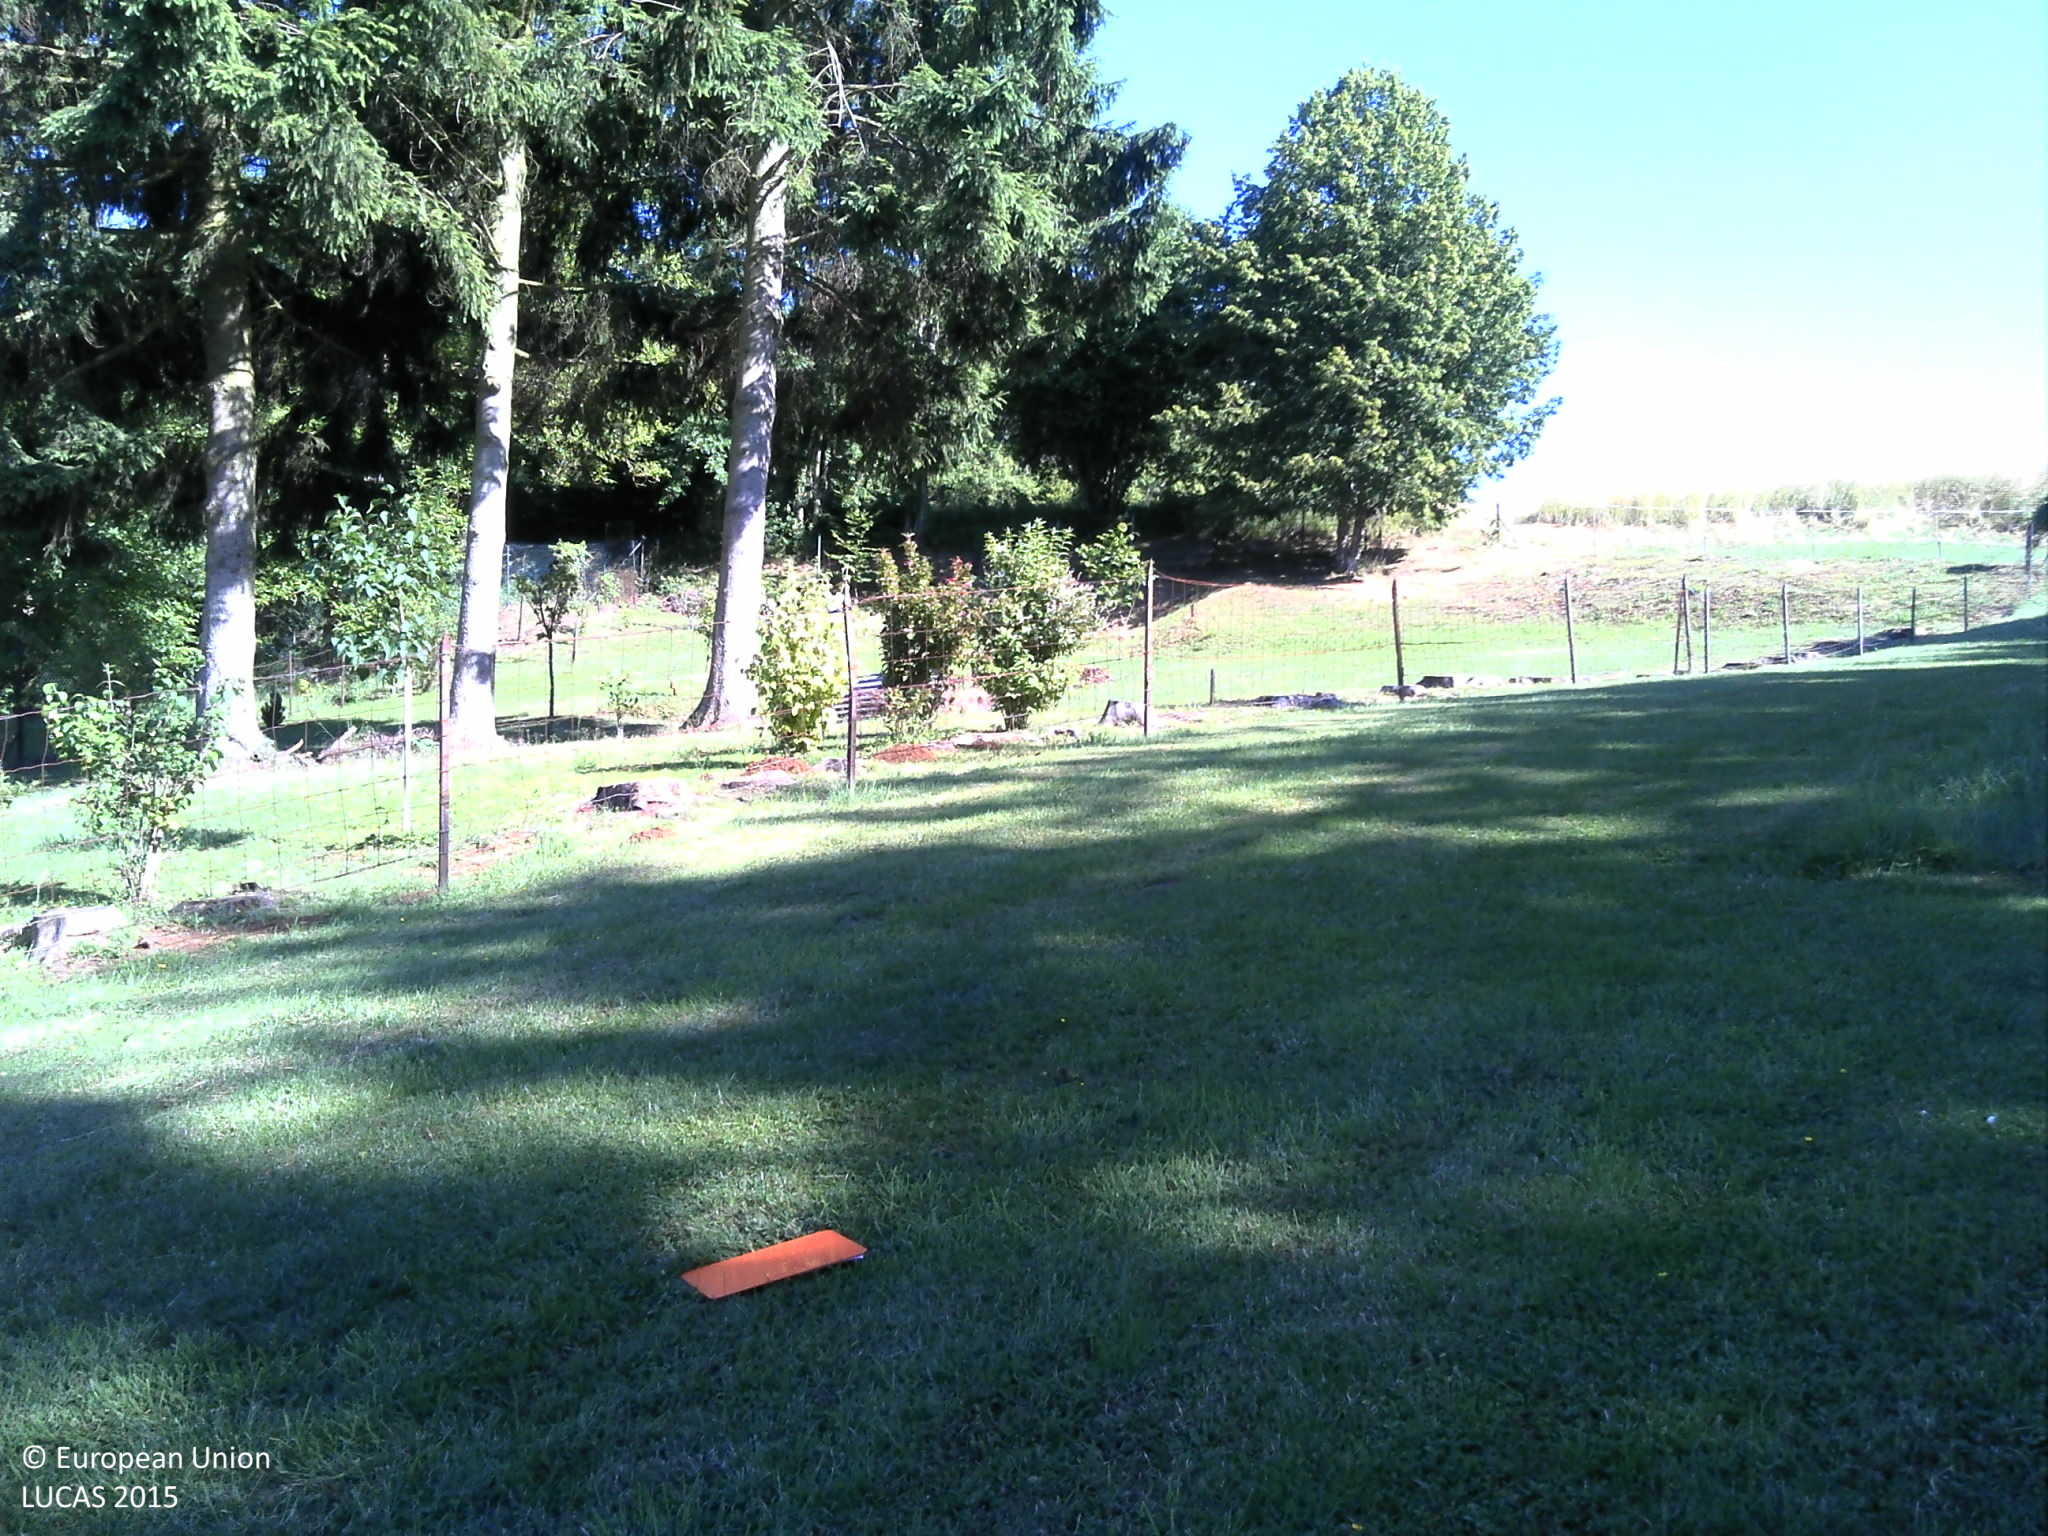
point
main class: Grassland
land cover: Grassland with sparse tree/shrub cover
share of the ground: > 75 %
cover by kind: herbaceous plants 95 %, broadleaved forest trees 5 %
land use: Residential
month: June
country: FR
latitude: 49.4144
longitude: 6.0710
